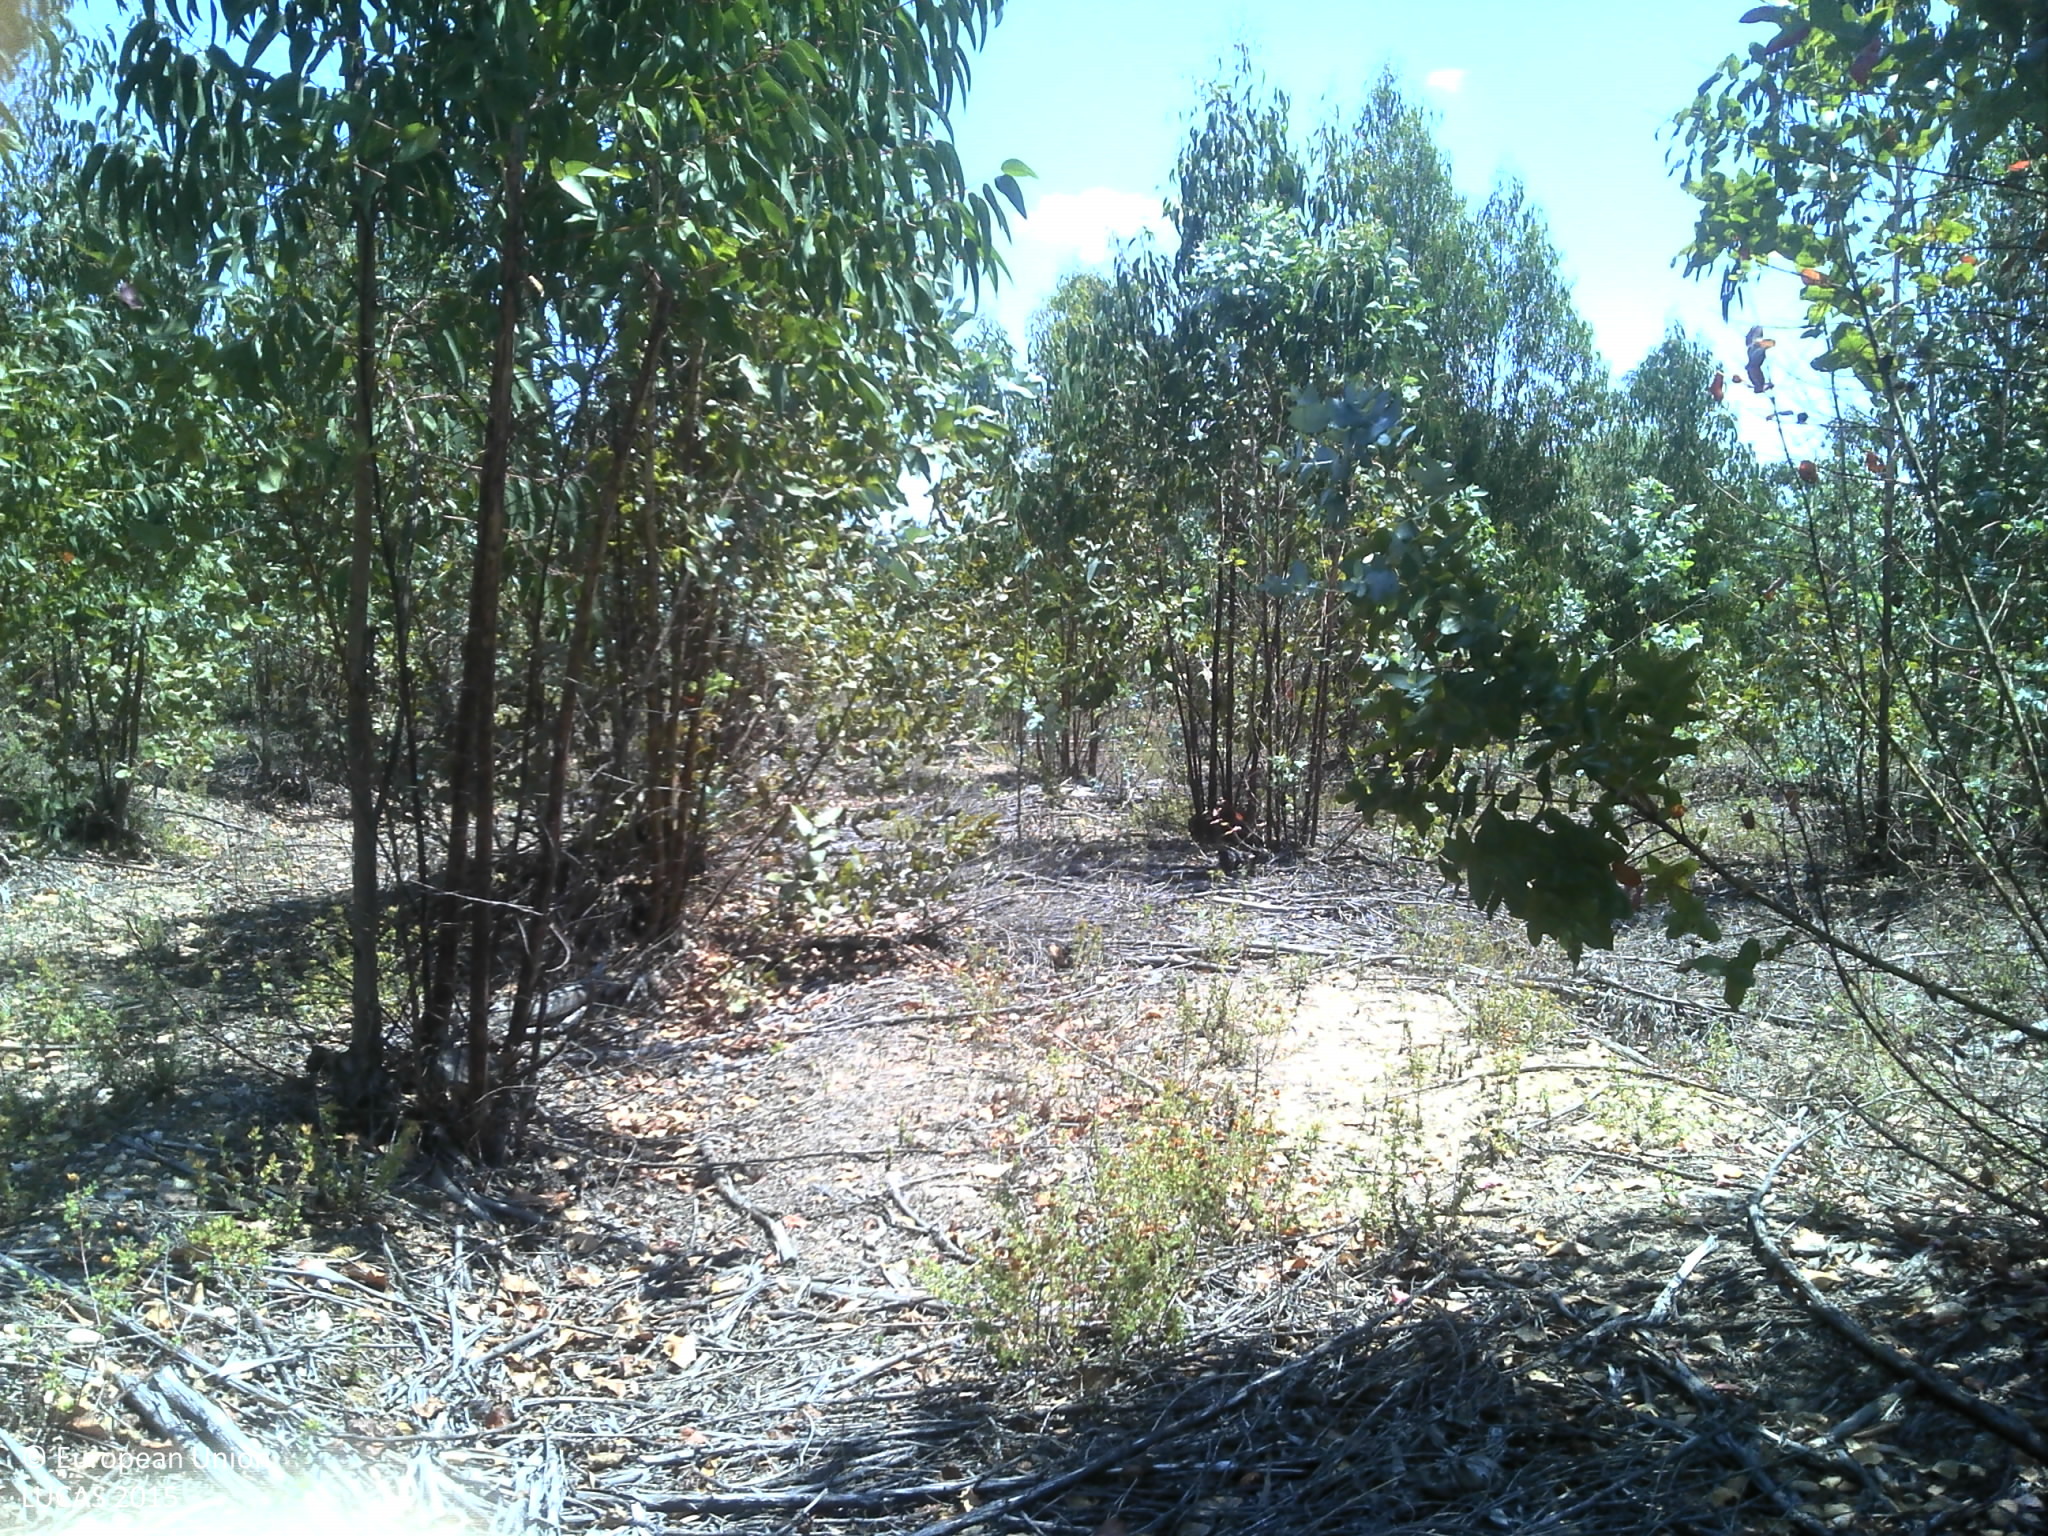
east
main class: Woodland
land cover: Broadleaved woodland
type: exotic forest
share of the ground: 50 - 75 %
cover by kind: broadleaved forest trees 75 %, shrubs 15 %, unconsolidated bare surface 10 %
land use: Forestry
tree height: > 5 m
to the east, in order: Broadleaved woodland; Tracks; Broadleaved woodland
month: June
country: PT
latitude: 39.2878
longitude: -8.3001
